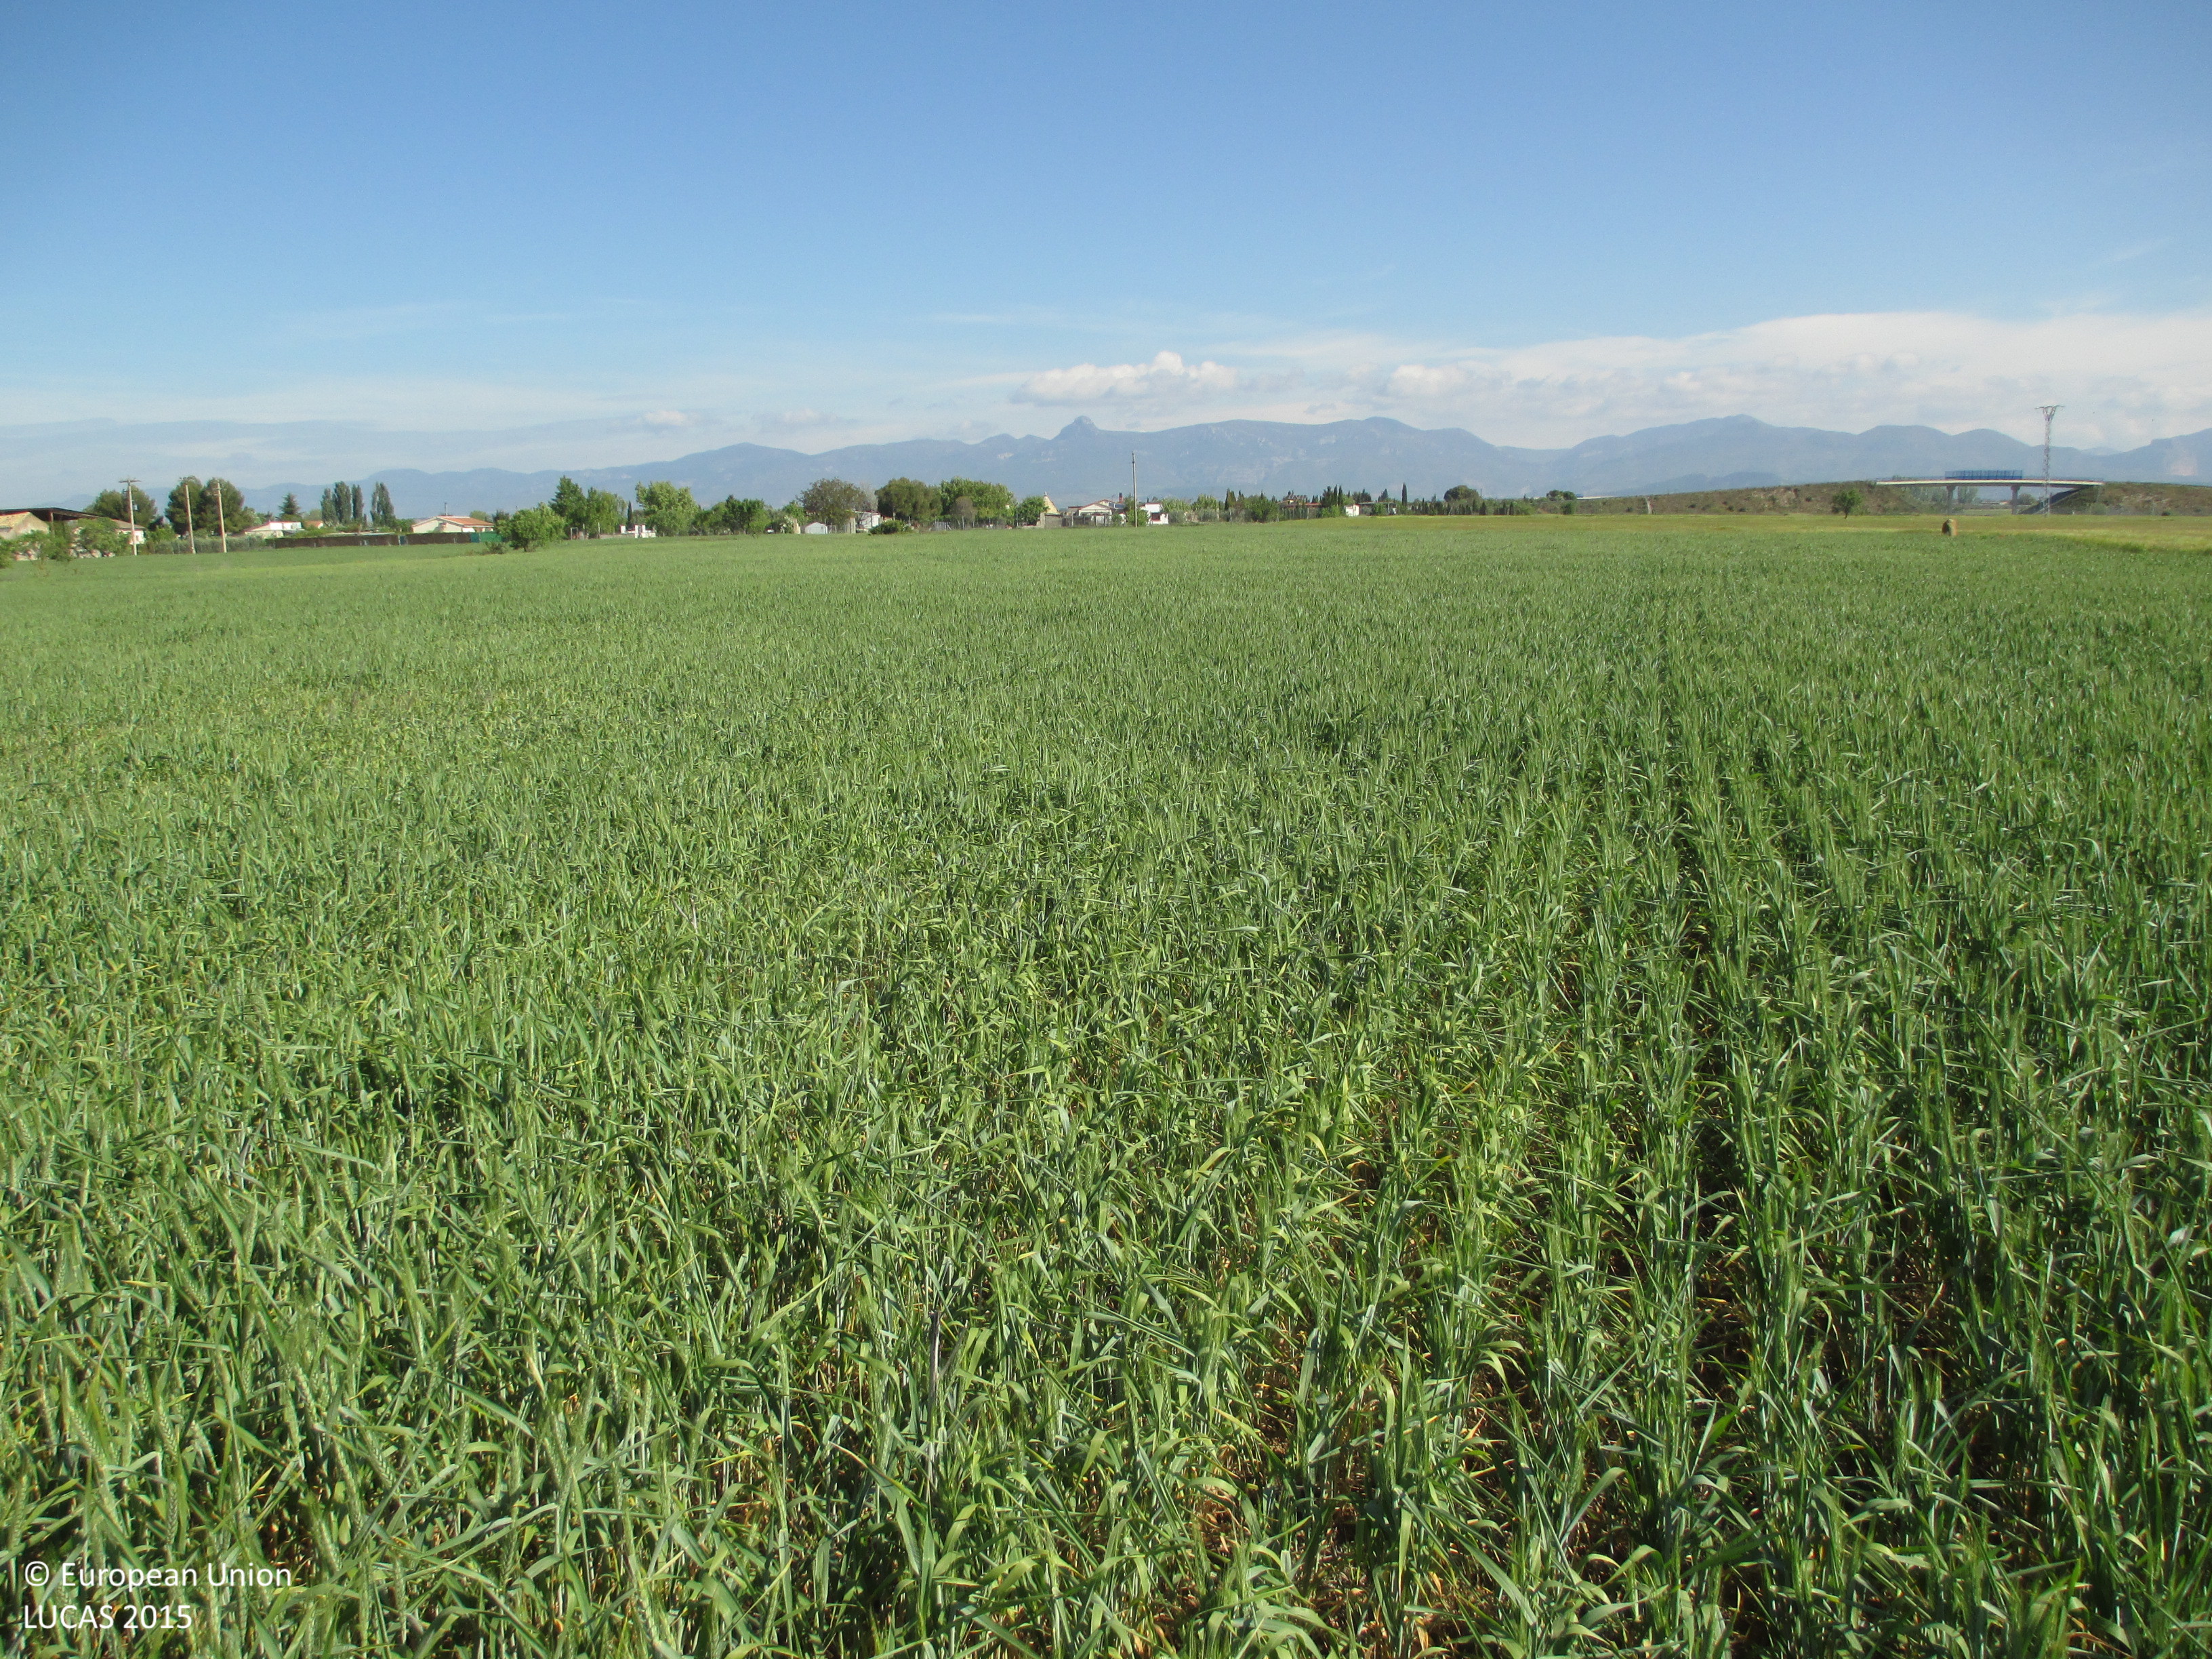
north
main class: Cropland
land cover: Durum wheat
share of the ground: > 75 %
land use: Agriculture (excluding fallow land and kitchen gardens)
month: April
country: ES
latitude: 42.1289
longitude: -0.4628
